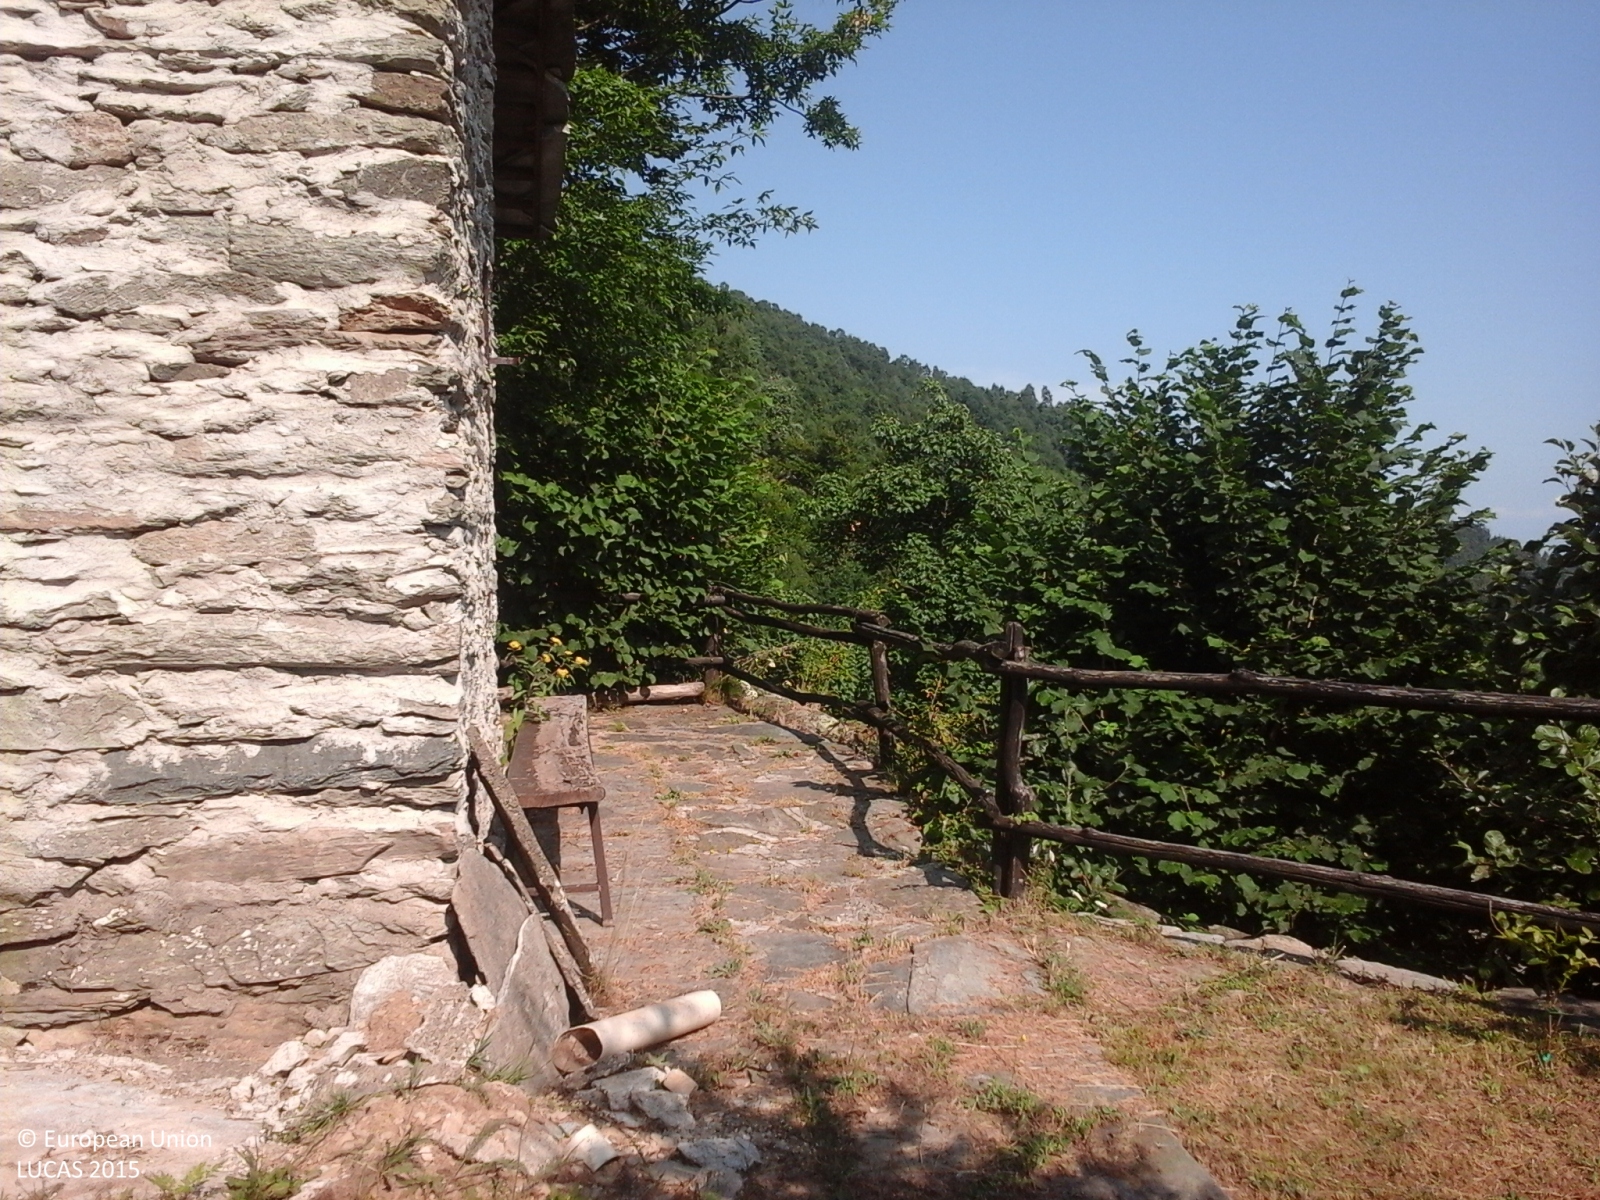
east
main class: Woodland
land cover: Broadleaved woodland
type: mesophytic deciduous forest
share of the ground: > 75 %
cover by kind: broadleaved forest trees 100 %
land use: Semi-natural and natural areas not in use
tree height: > 5 m
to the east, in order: Broadleaved woodland; Artificial constructions in urban areas; Broadleaved woodland; Paved roads, cycling and walking lanes; Broadleaved woodland; Tracks; Broadleaved woodland
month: July
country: IT
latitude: 44.8723
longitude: 7.2076
